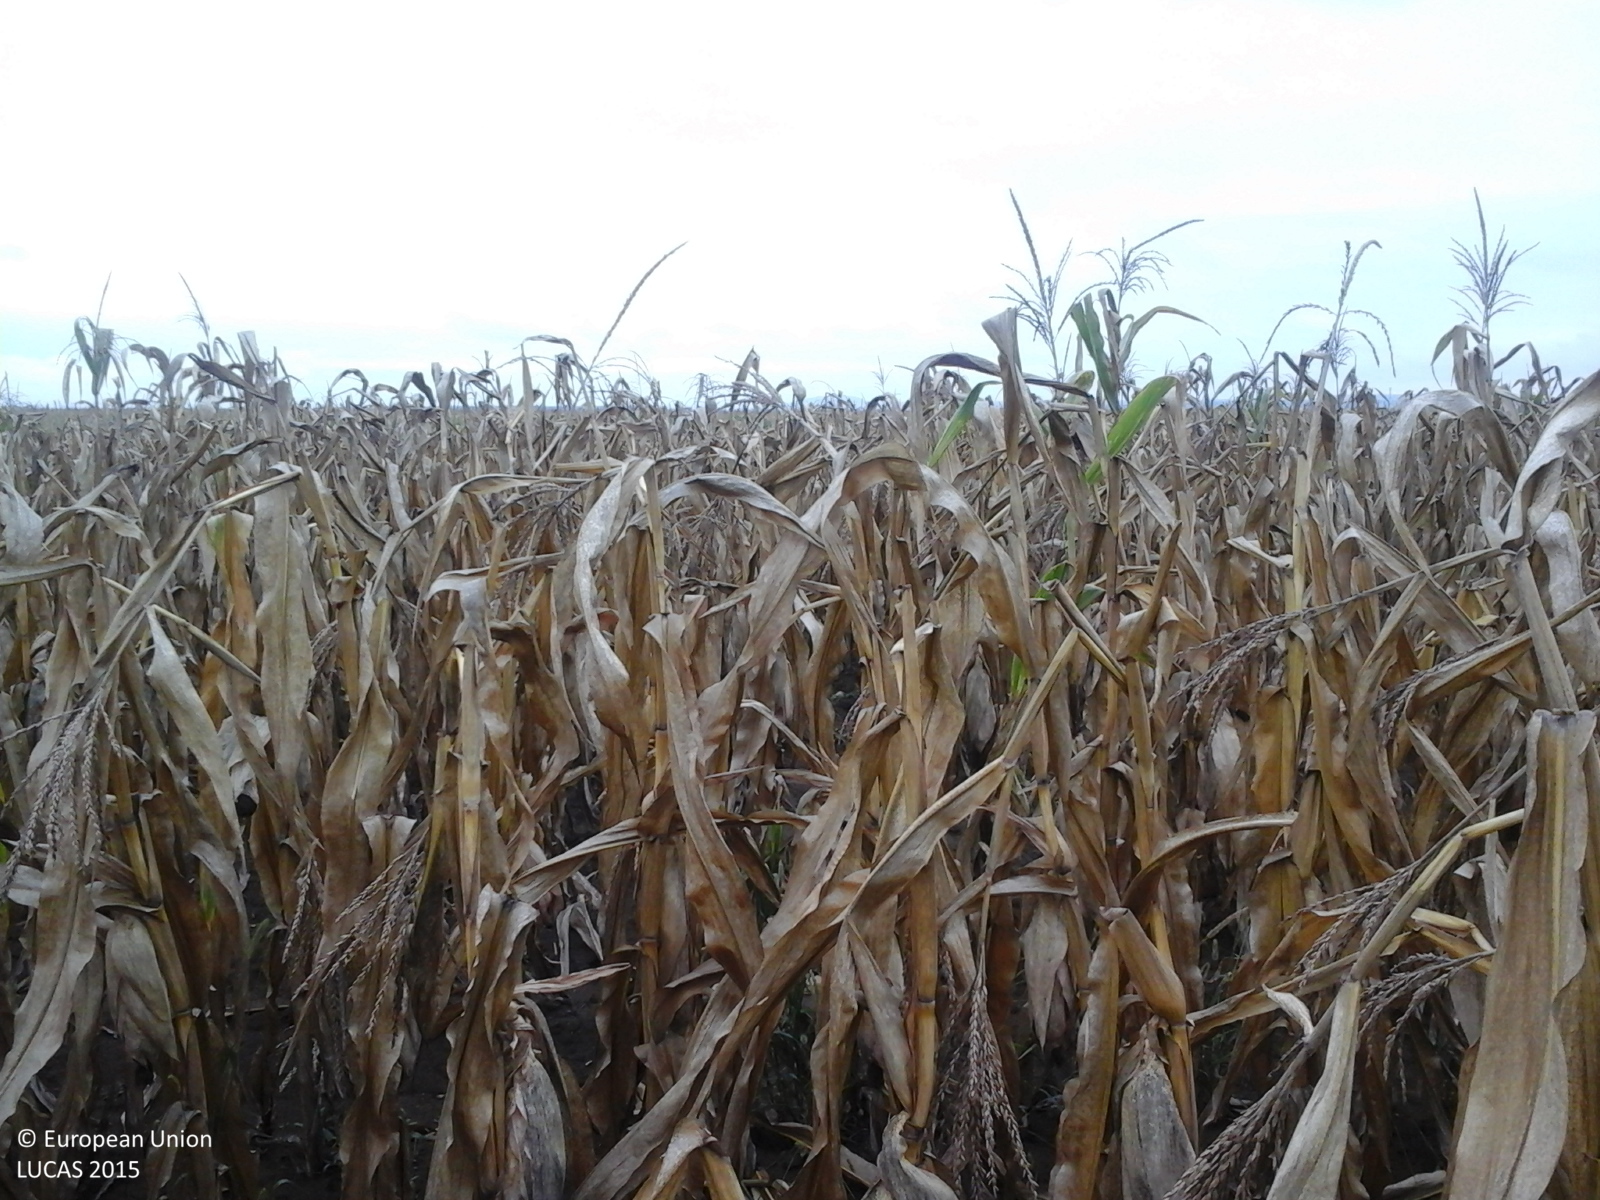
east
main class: Cropland
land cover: Maize
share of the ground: > 75 %
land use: Agriculture (excluding fallow land and kitchen gardens)
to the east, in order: Maize; Common wheat; Maize
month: September
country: RO
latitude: 47.0007
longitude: 21.8416
